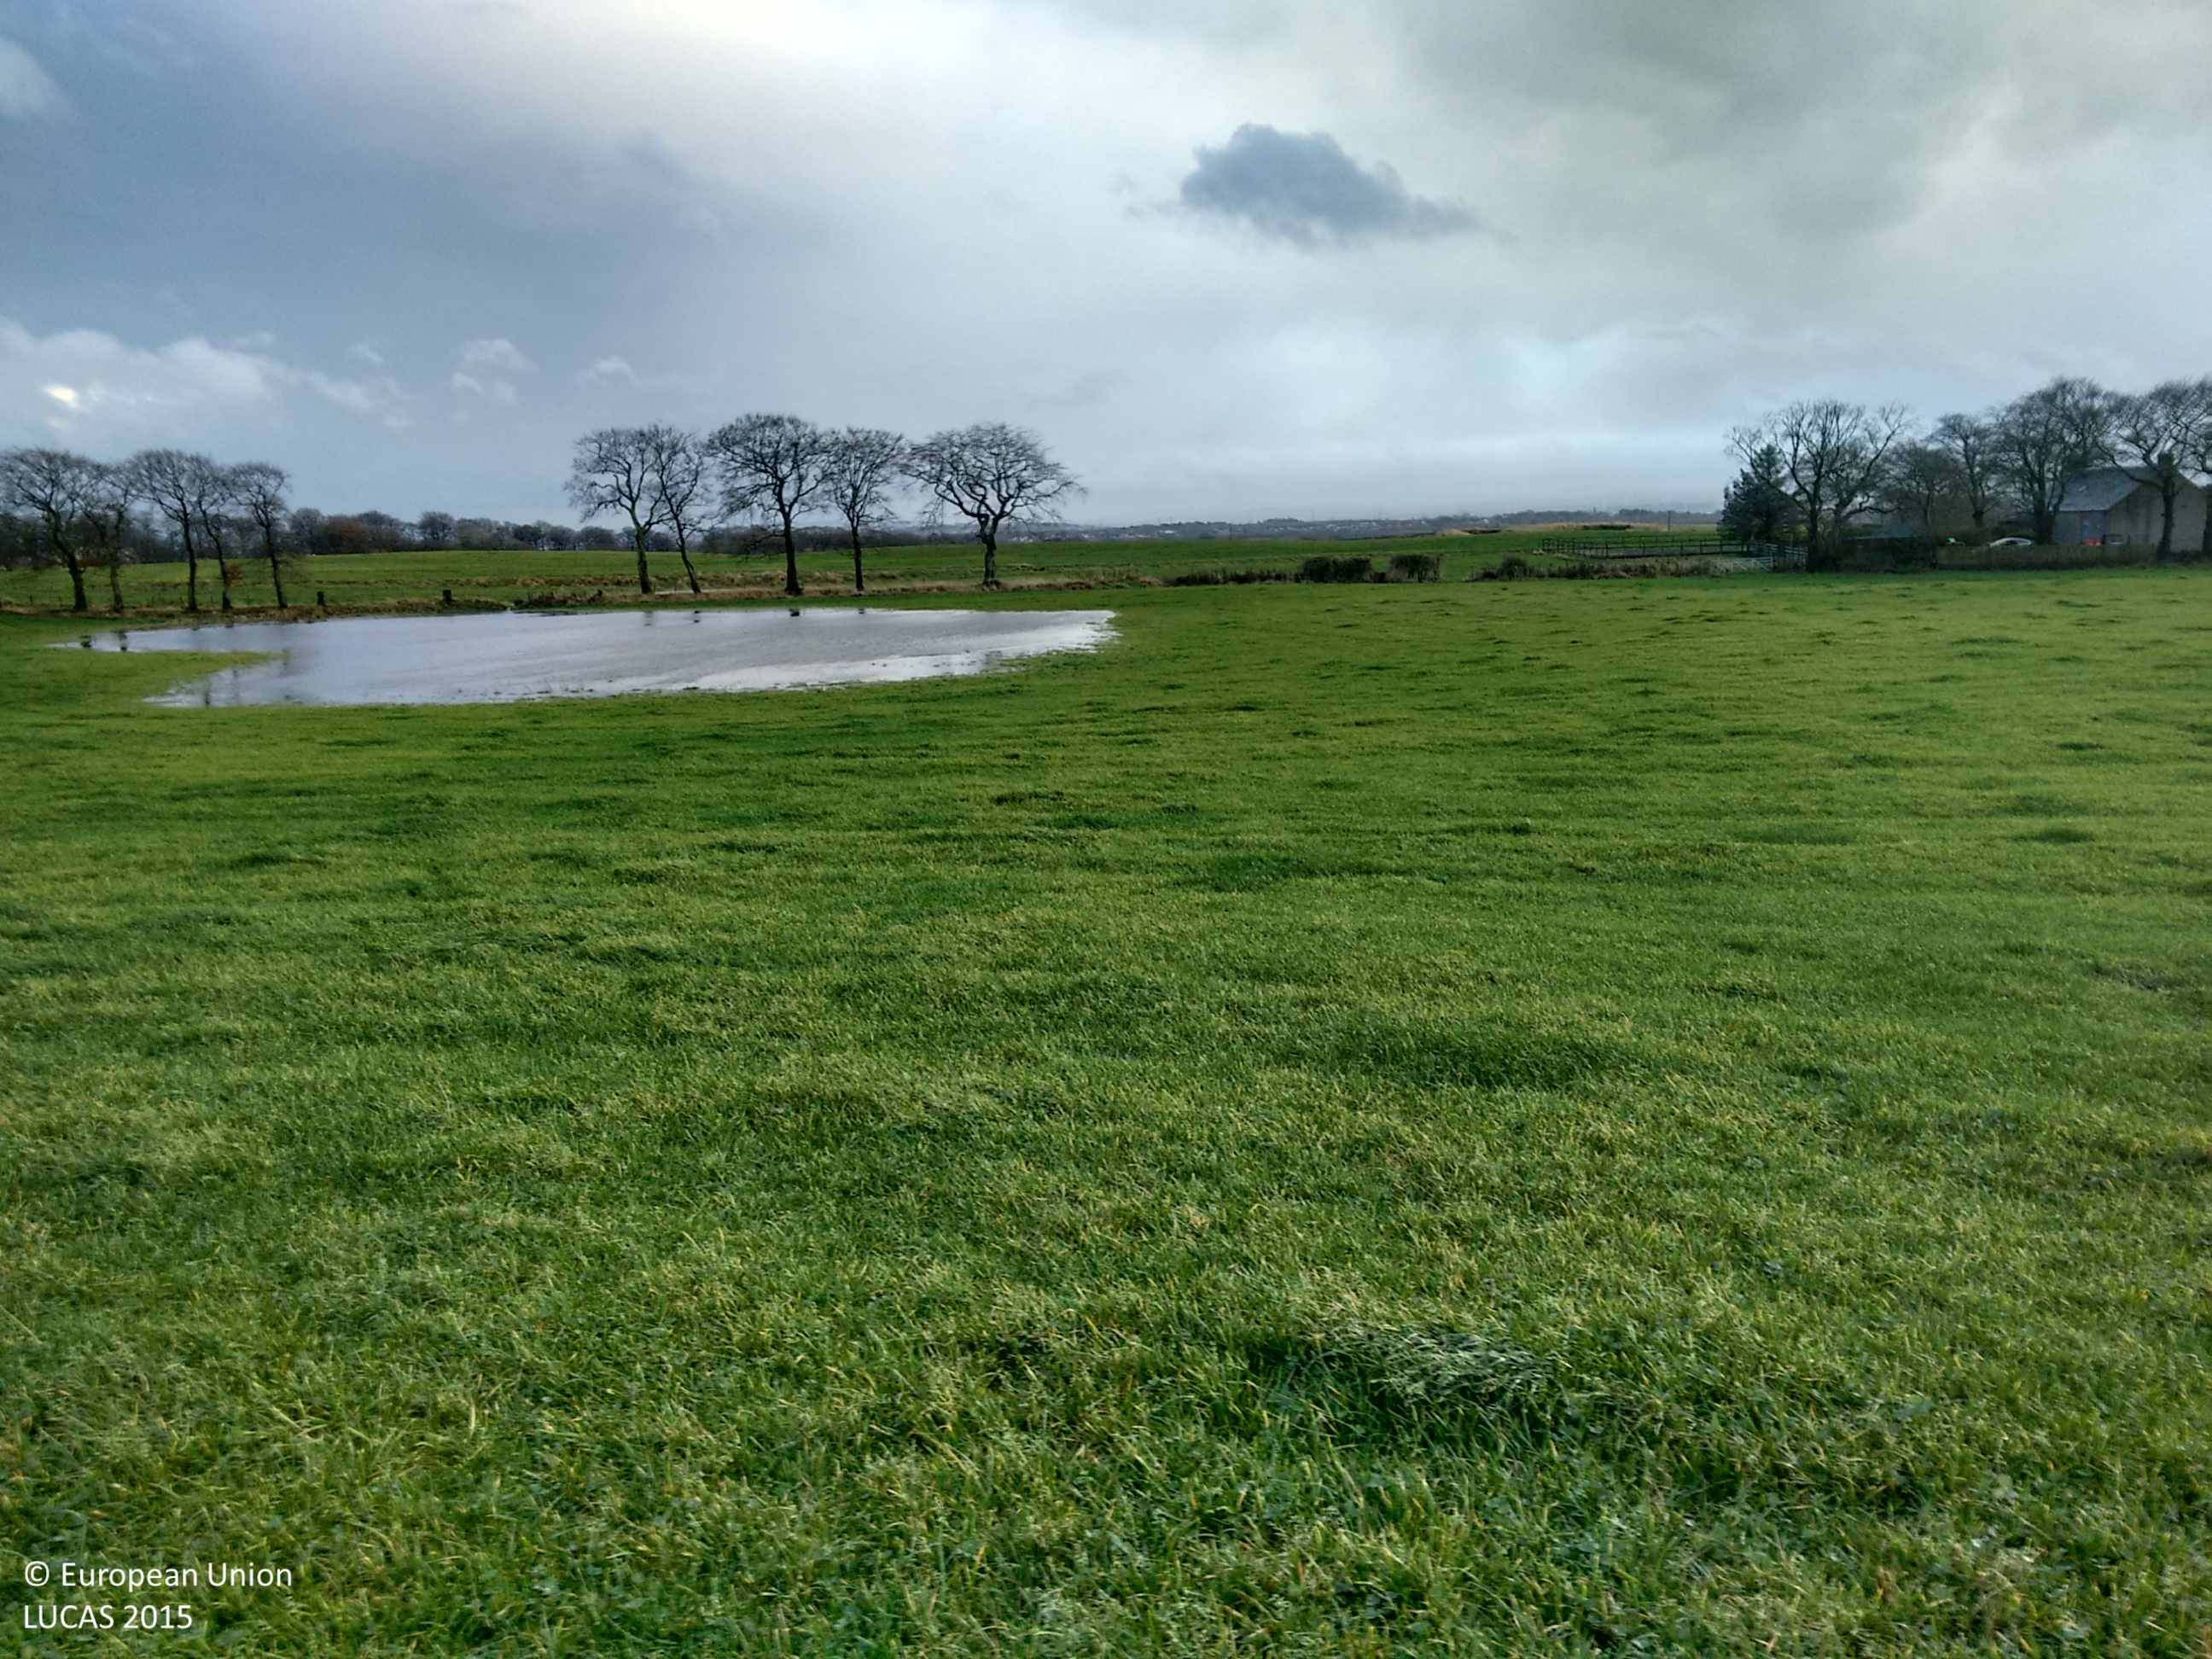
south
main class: Grassland
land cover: Grassland without tree/shrub cover
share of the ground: > 75 %
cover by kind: herbaceous plants 100 %
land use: Agriculture (excluding fallow land and kitchen gardens)
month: November
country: GB
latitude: 55.8112
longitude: -3.8884
